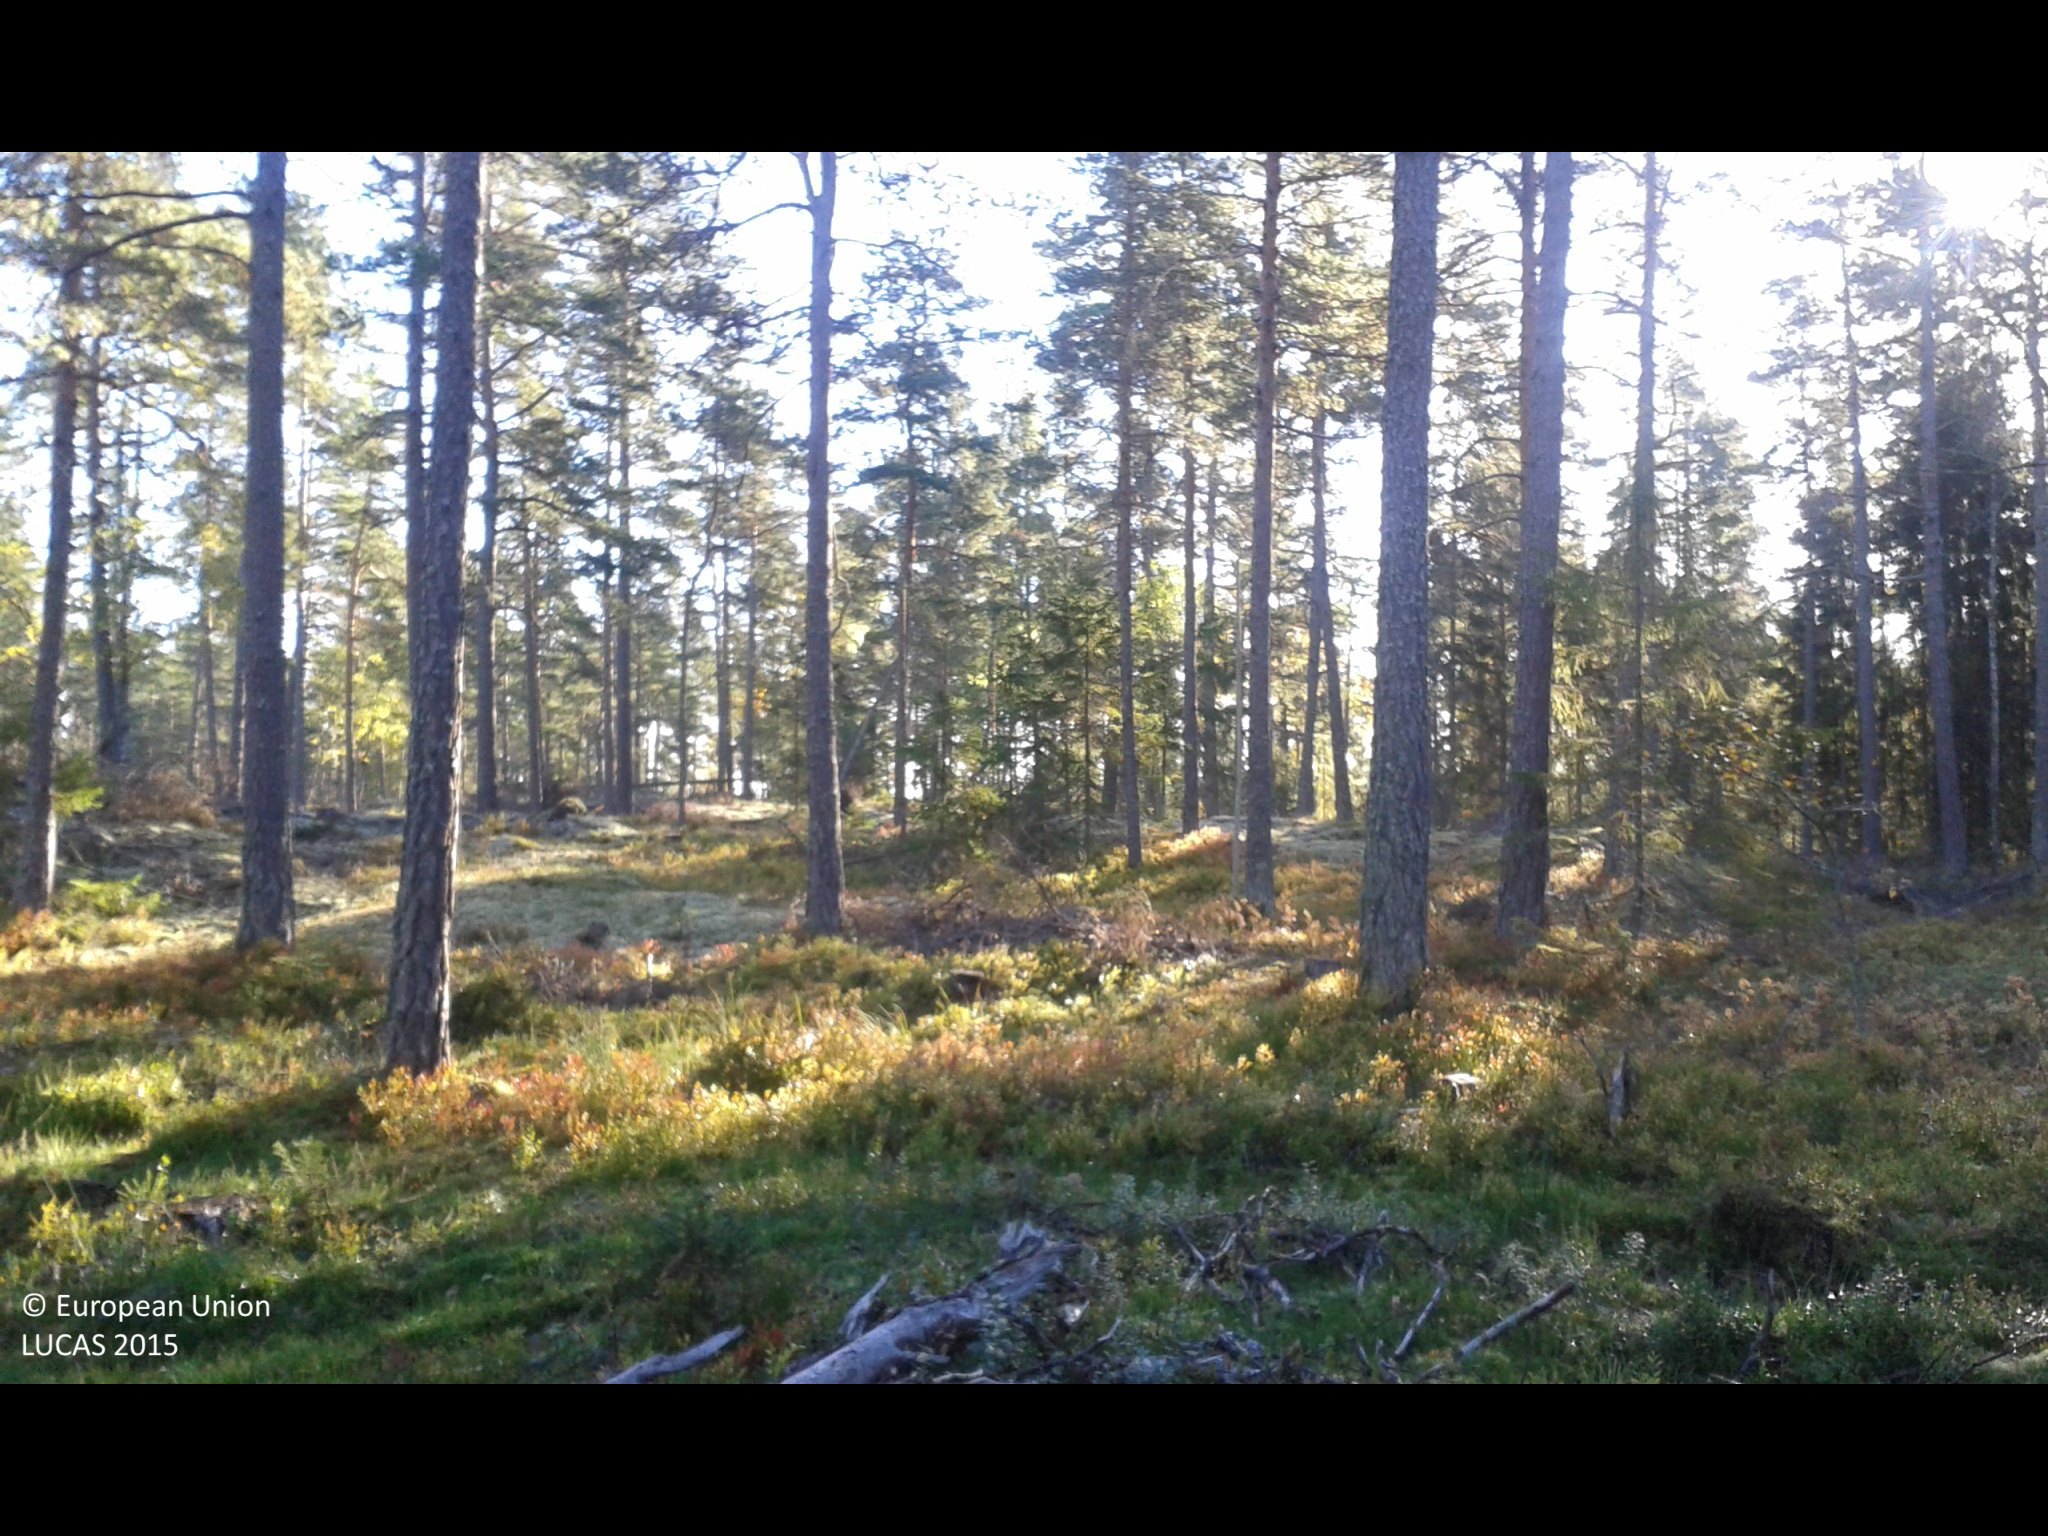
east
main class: Woodland
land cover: Pine dominated coniferous woodland
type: boreal forest
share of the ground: 50 - 75 %
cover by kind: coniferous forest trees 60 %, herbaceous plants 30 %, broadleaved forest trees 10 %
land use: Forestry
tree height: > 5 m
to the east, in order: Pine dominated coniferous woodland; Pine dominated mixed woodland; Electric lines
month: October
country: SE
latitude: 59.0240
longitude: 17.4703
